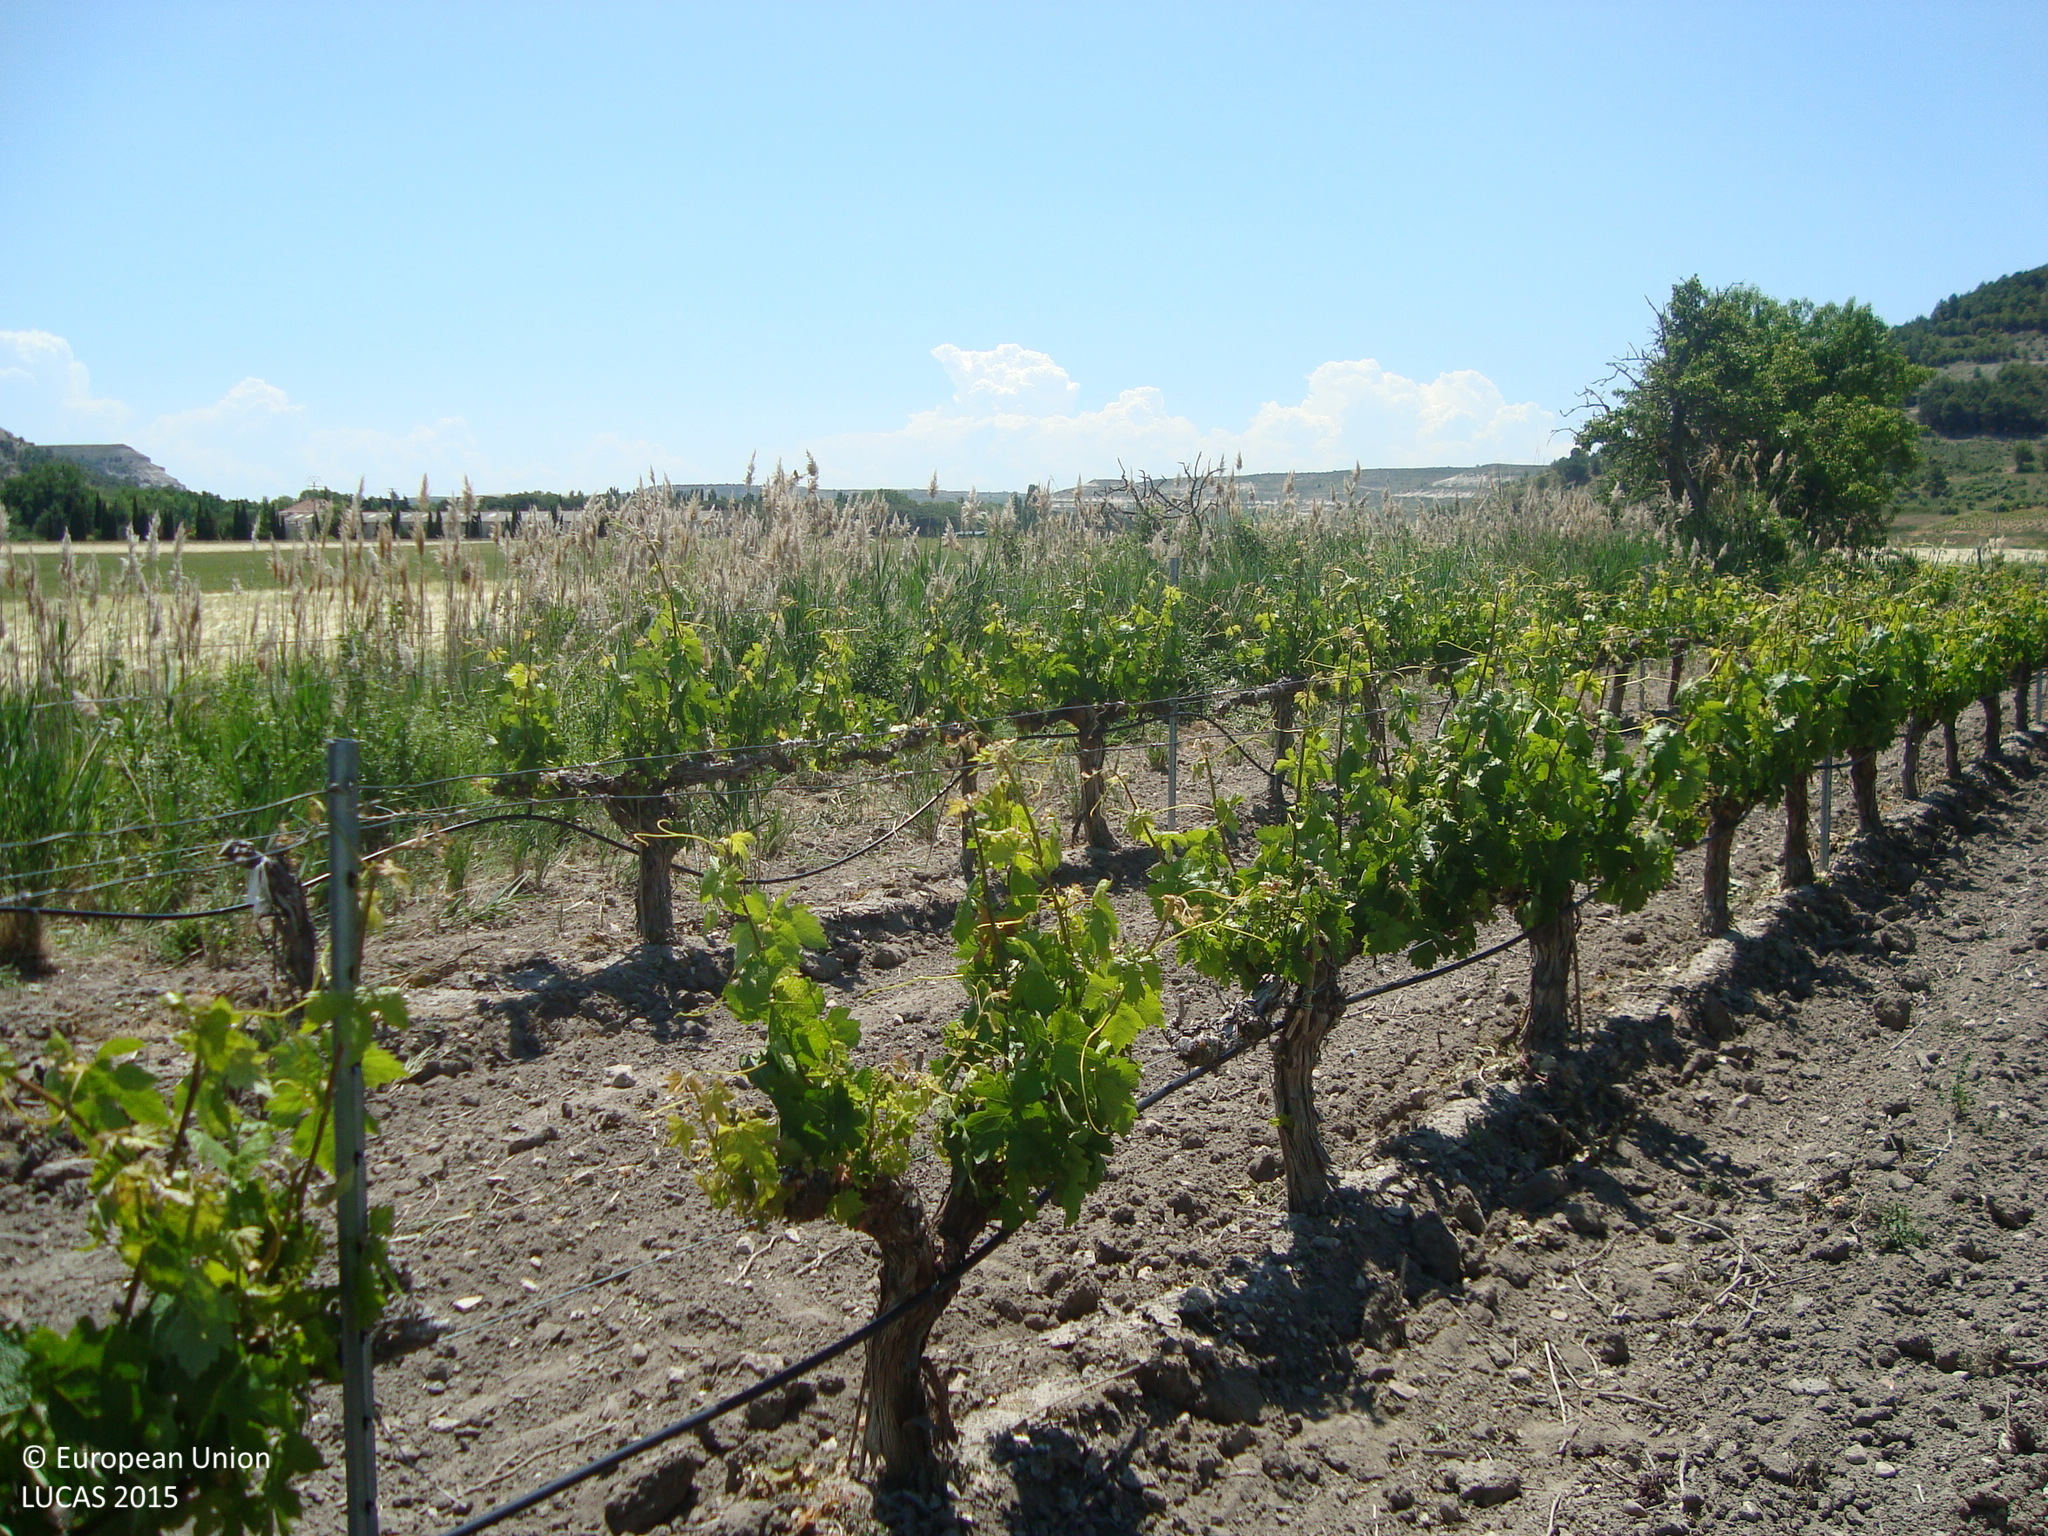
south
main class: Cropland
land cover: Vineyards
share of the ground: 10 - 25 %
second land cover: Other bare soil
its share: > 75 %
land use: Agriculture (excluding fallow land and kitchen gardens)
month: May
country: ES
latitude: 41.5670
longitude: -4.1246
